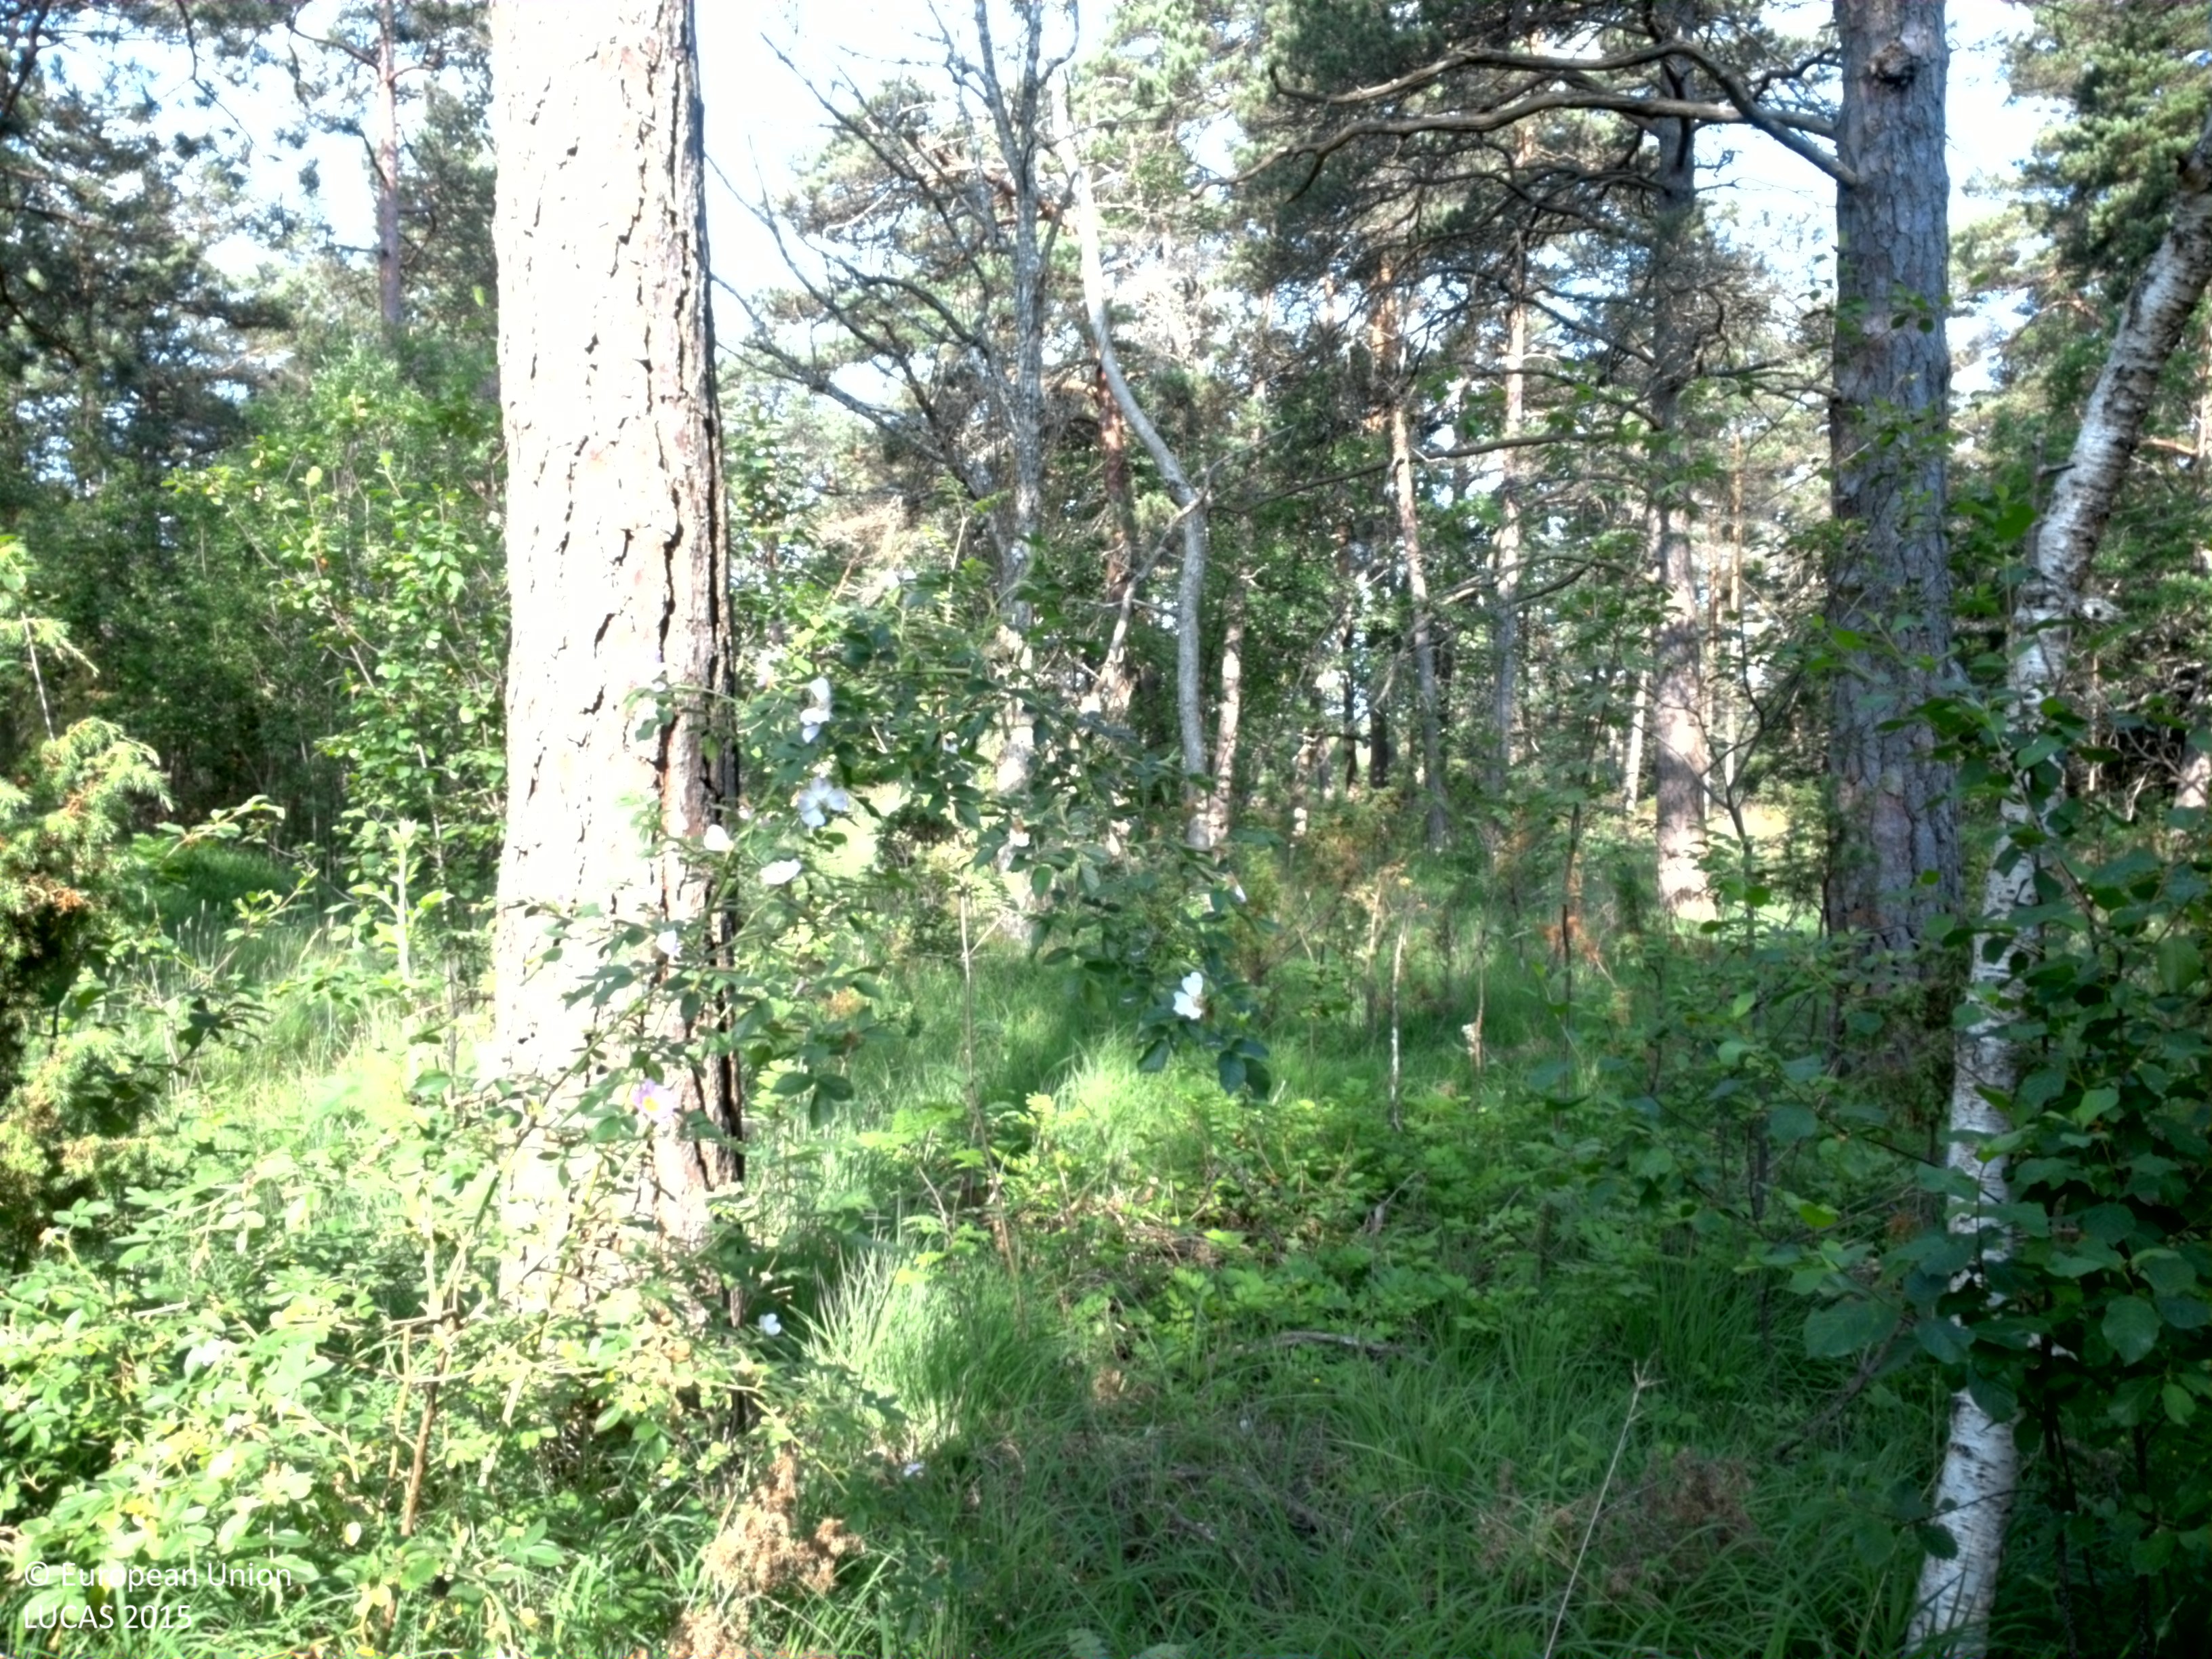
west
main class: Woodland
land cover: Pine dominated coniferous woodland
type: hemiboreal forest and nemoral coniferous forest and mixed broadleaved-coniferous forest
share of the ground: 50 - 75 %
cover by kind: coniferous forest trees 70 %, shrubs 15 %, herbaceous plants 15 %
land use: Forestry
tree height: > 5 m
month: July
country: SE
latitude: 57.6806
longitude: 18.7469
